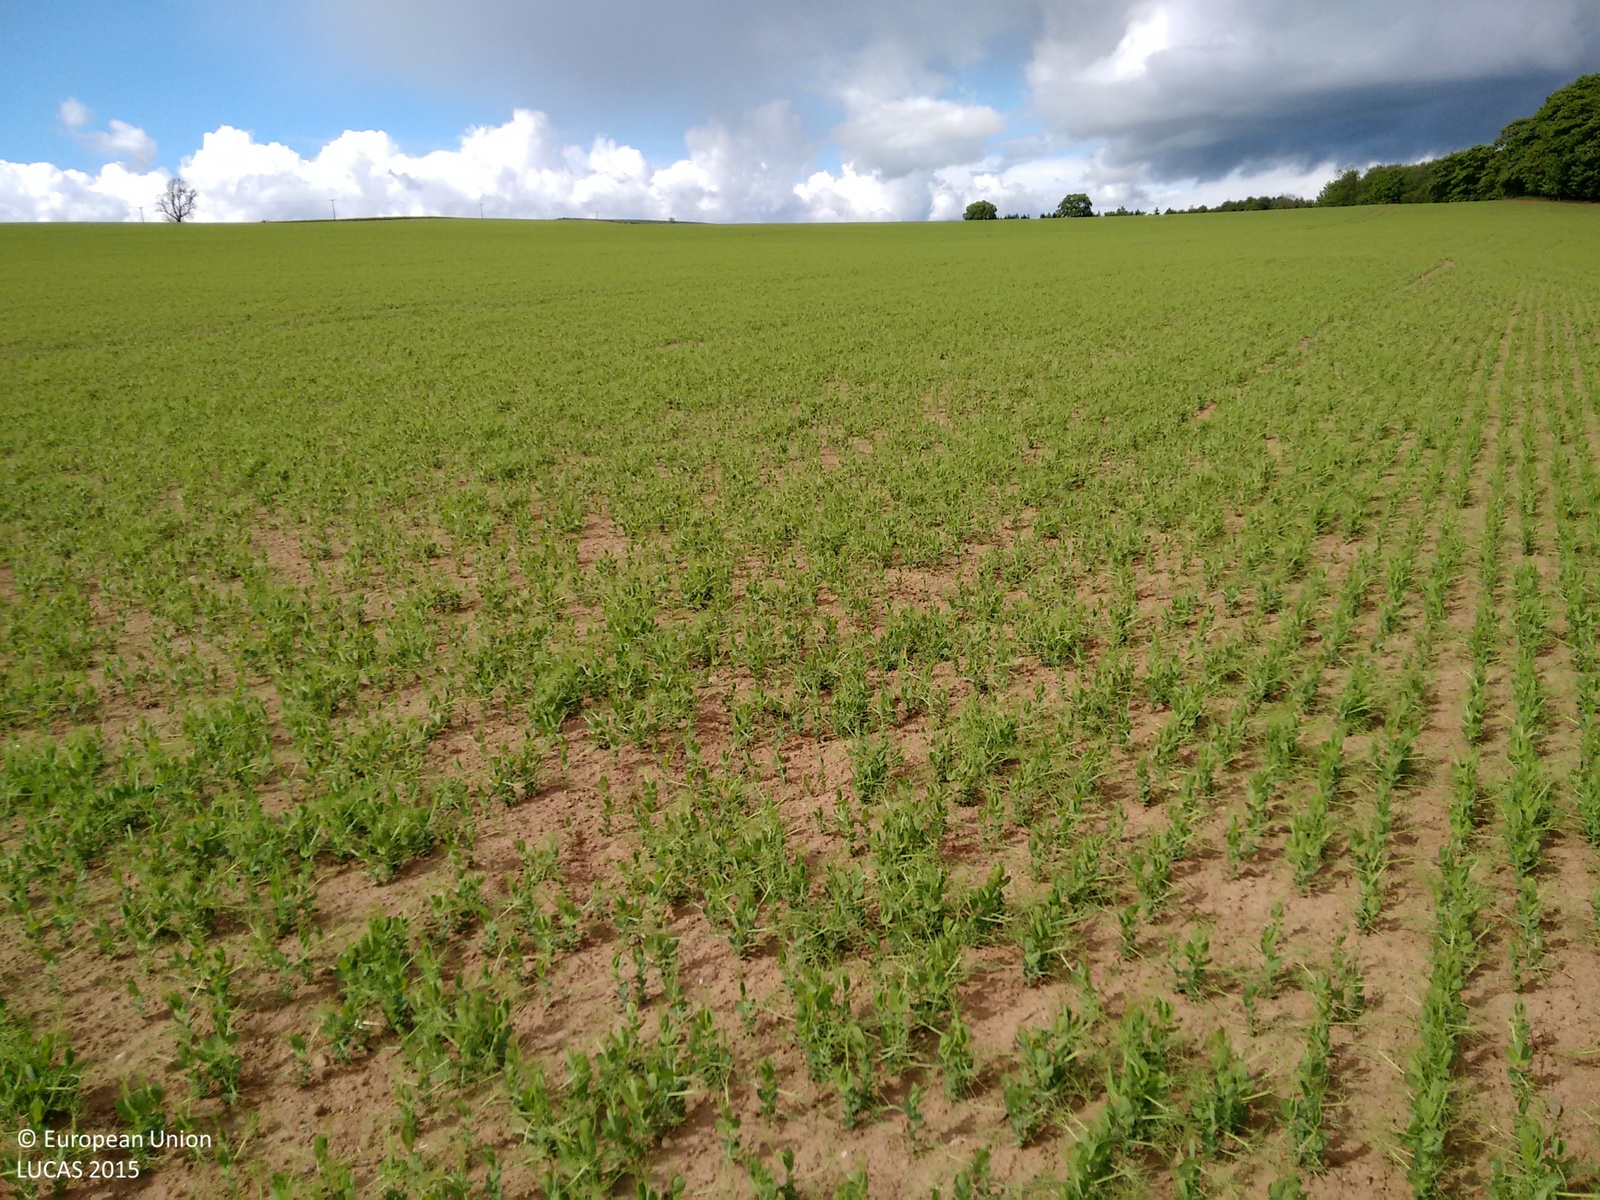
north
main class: Cropland
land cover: Dry pulses
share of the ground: 25 - 50 %
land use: Agriculture (excluding fallow land and kitchen gardens)
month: May
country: GB
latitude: 55.5433
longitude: -2.4372
